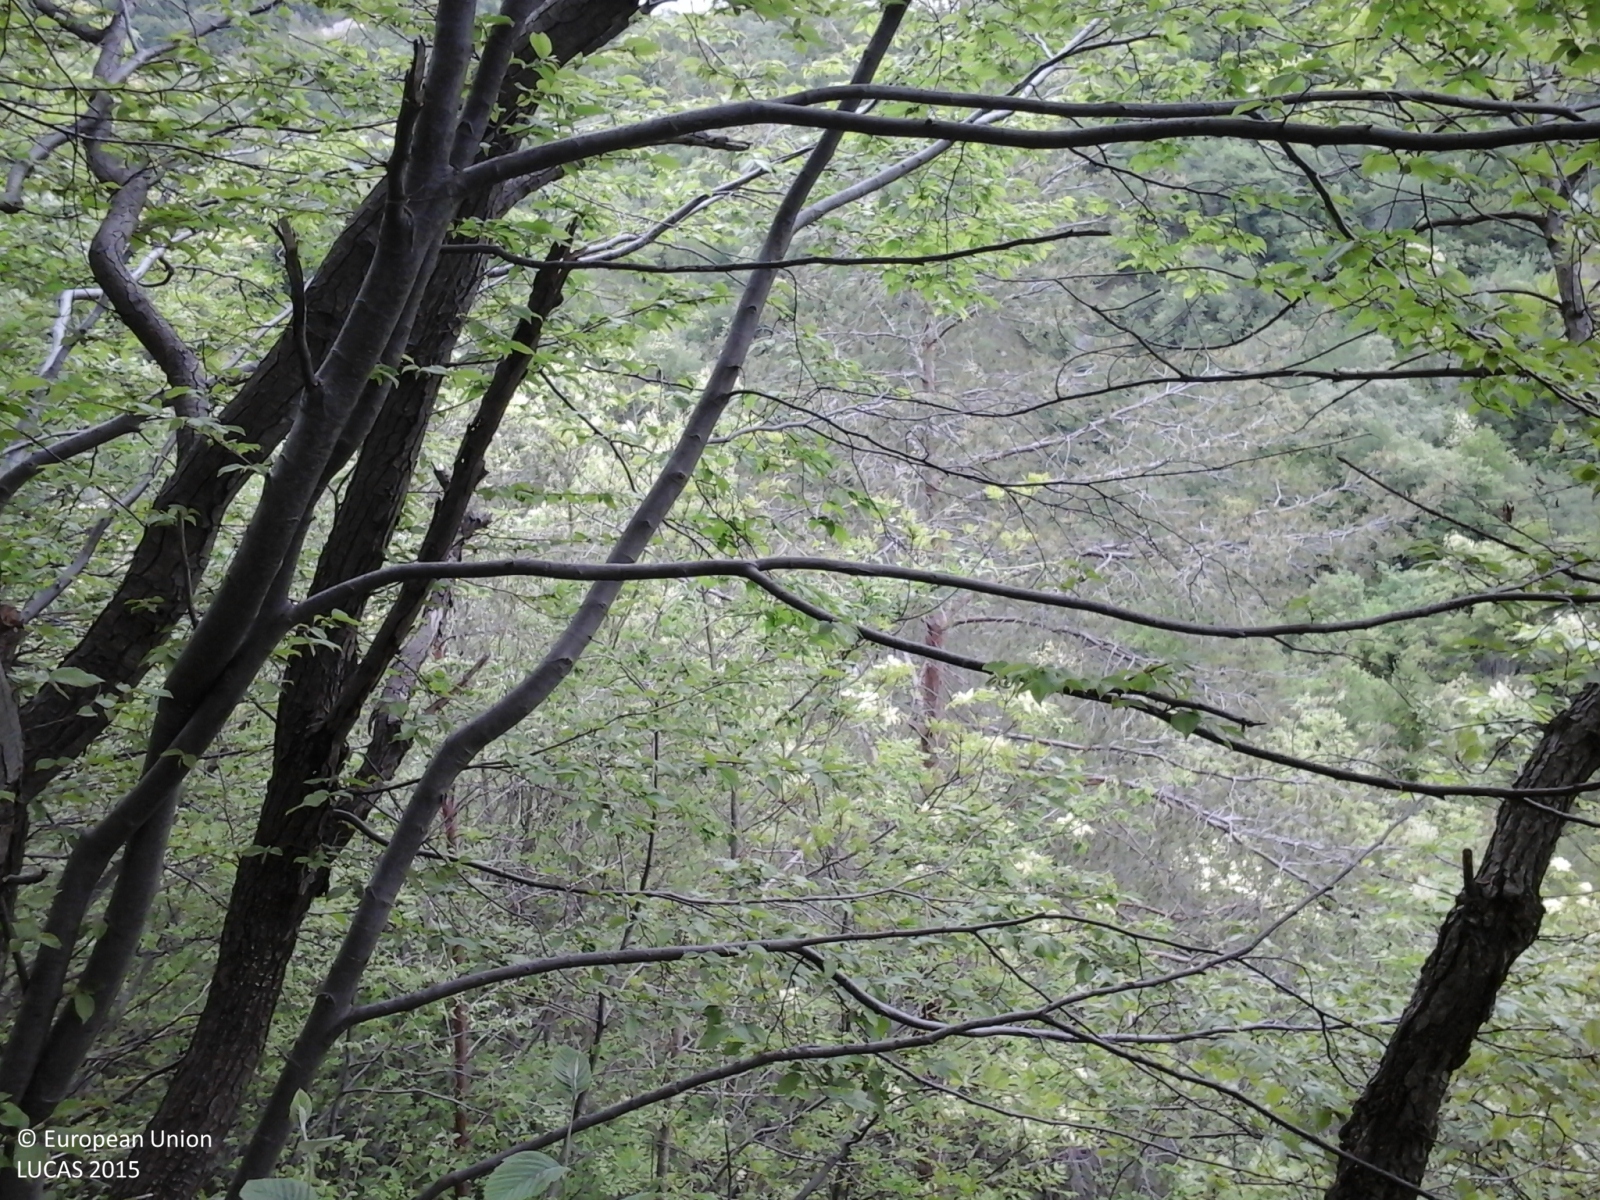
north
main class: Woodland
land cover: Broadleaved woodland
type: mesophytic deciduous forest
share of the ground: > 75 %
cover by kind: broadleaved forest trees 90 %, shrubs 10 %
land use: Semi-natural and natural areas not in use
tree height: > 5 m
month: April
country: IT
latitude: 45.9326
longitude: 12.1766
